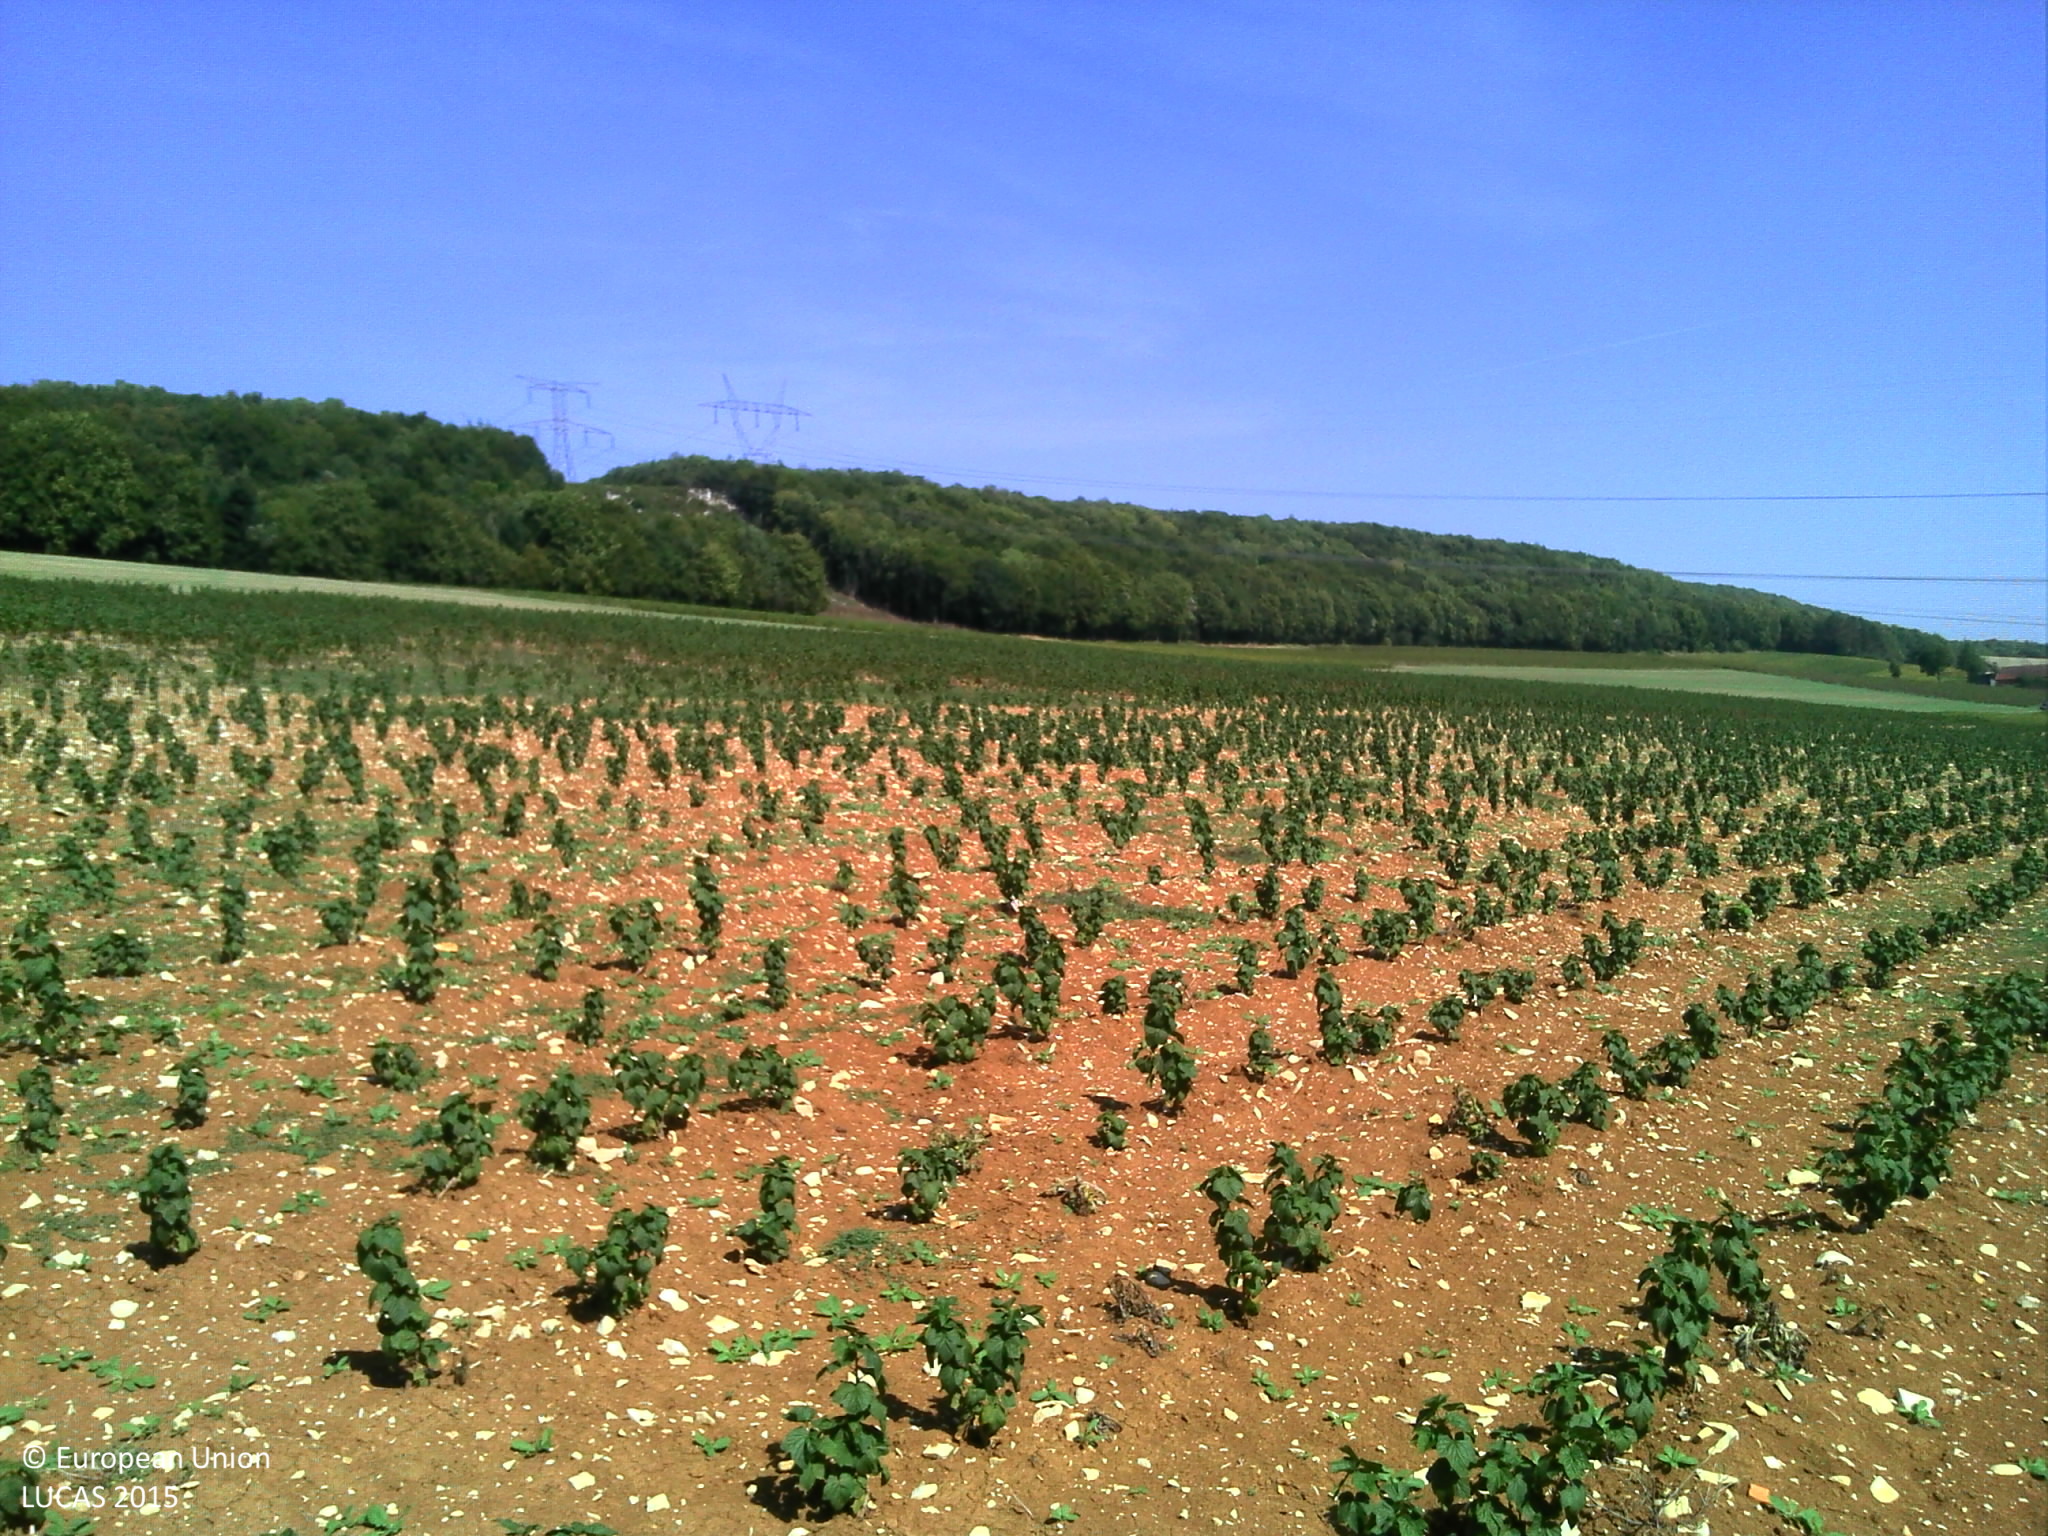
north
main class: Cropland
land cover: Other non-permanent industrial crops
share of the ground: 10 - 25 %
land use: Agriculture (excluding fallow land and kitchen gardens)
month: August
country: FR
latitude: 47.2536
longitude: 4.8073
